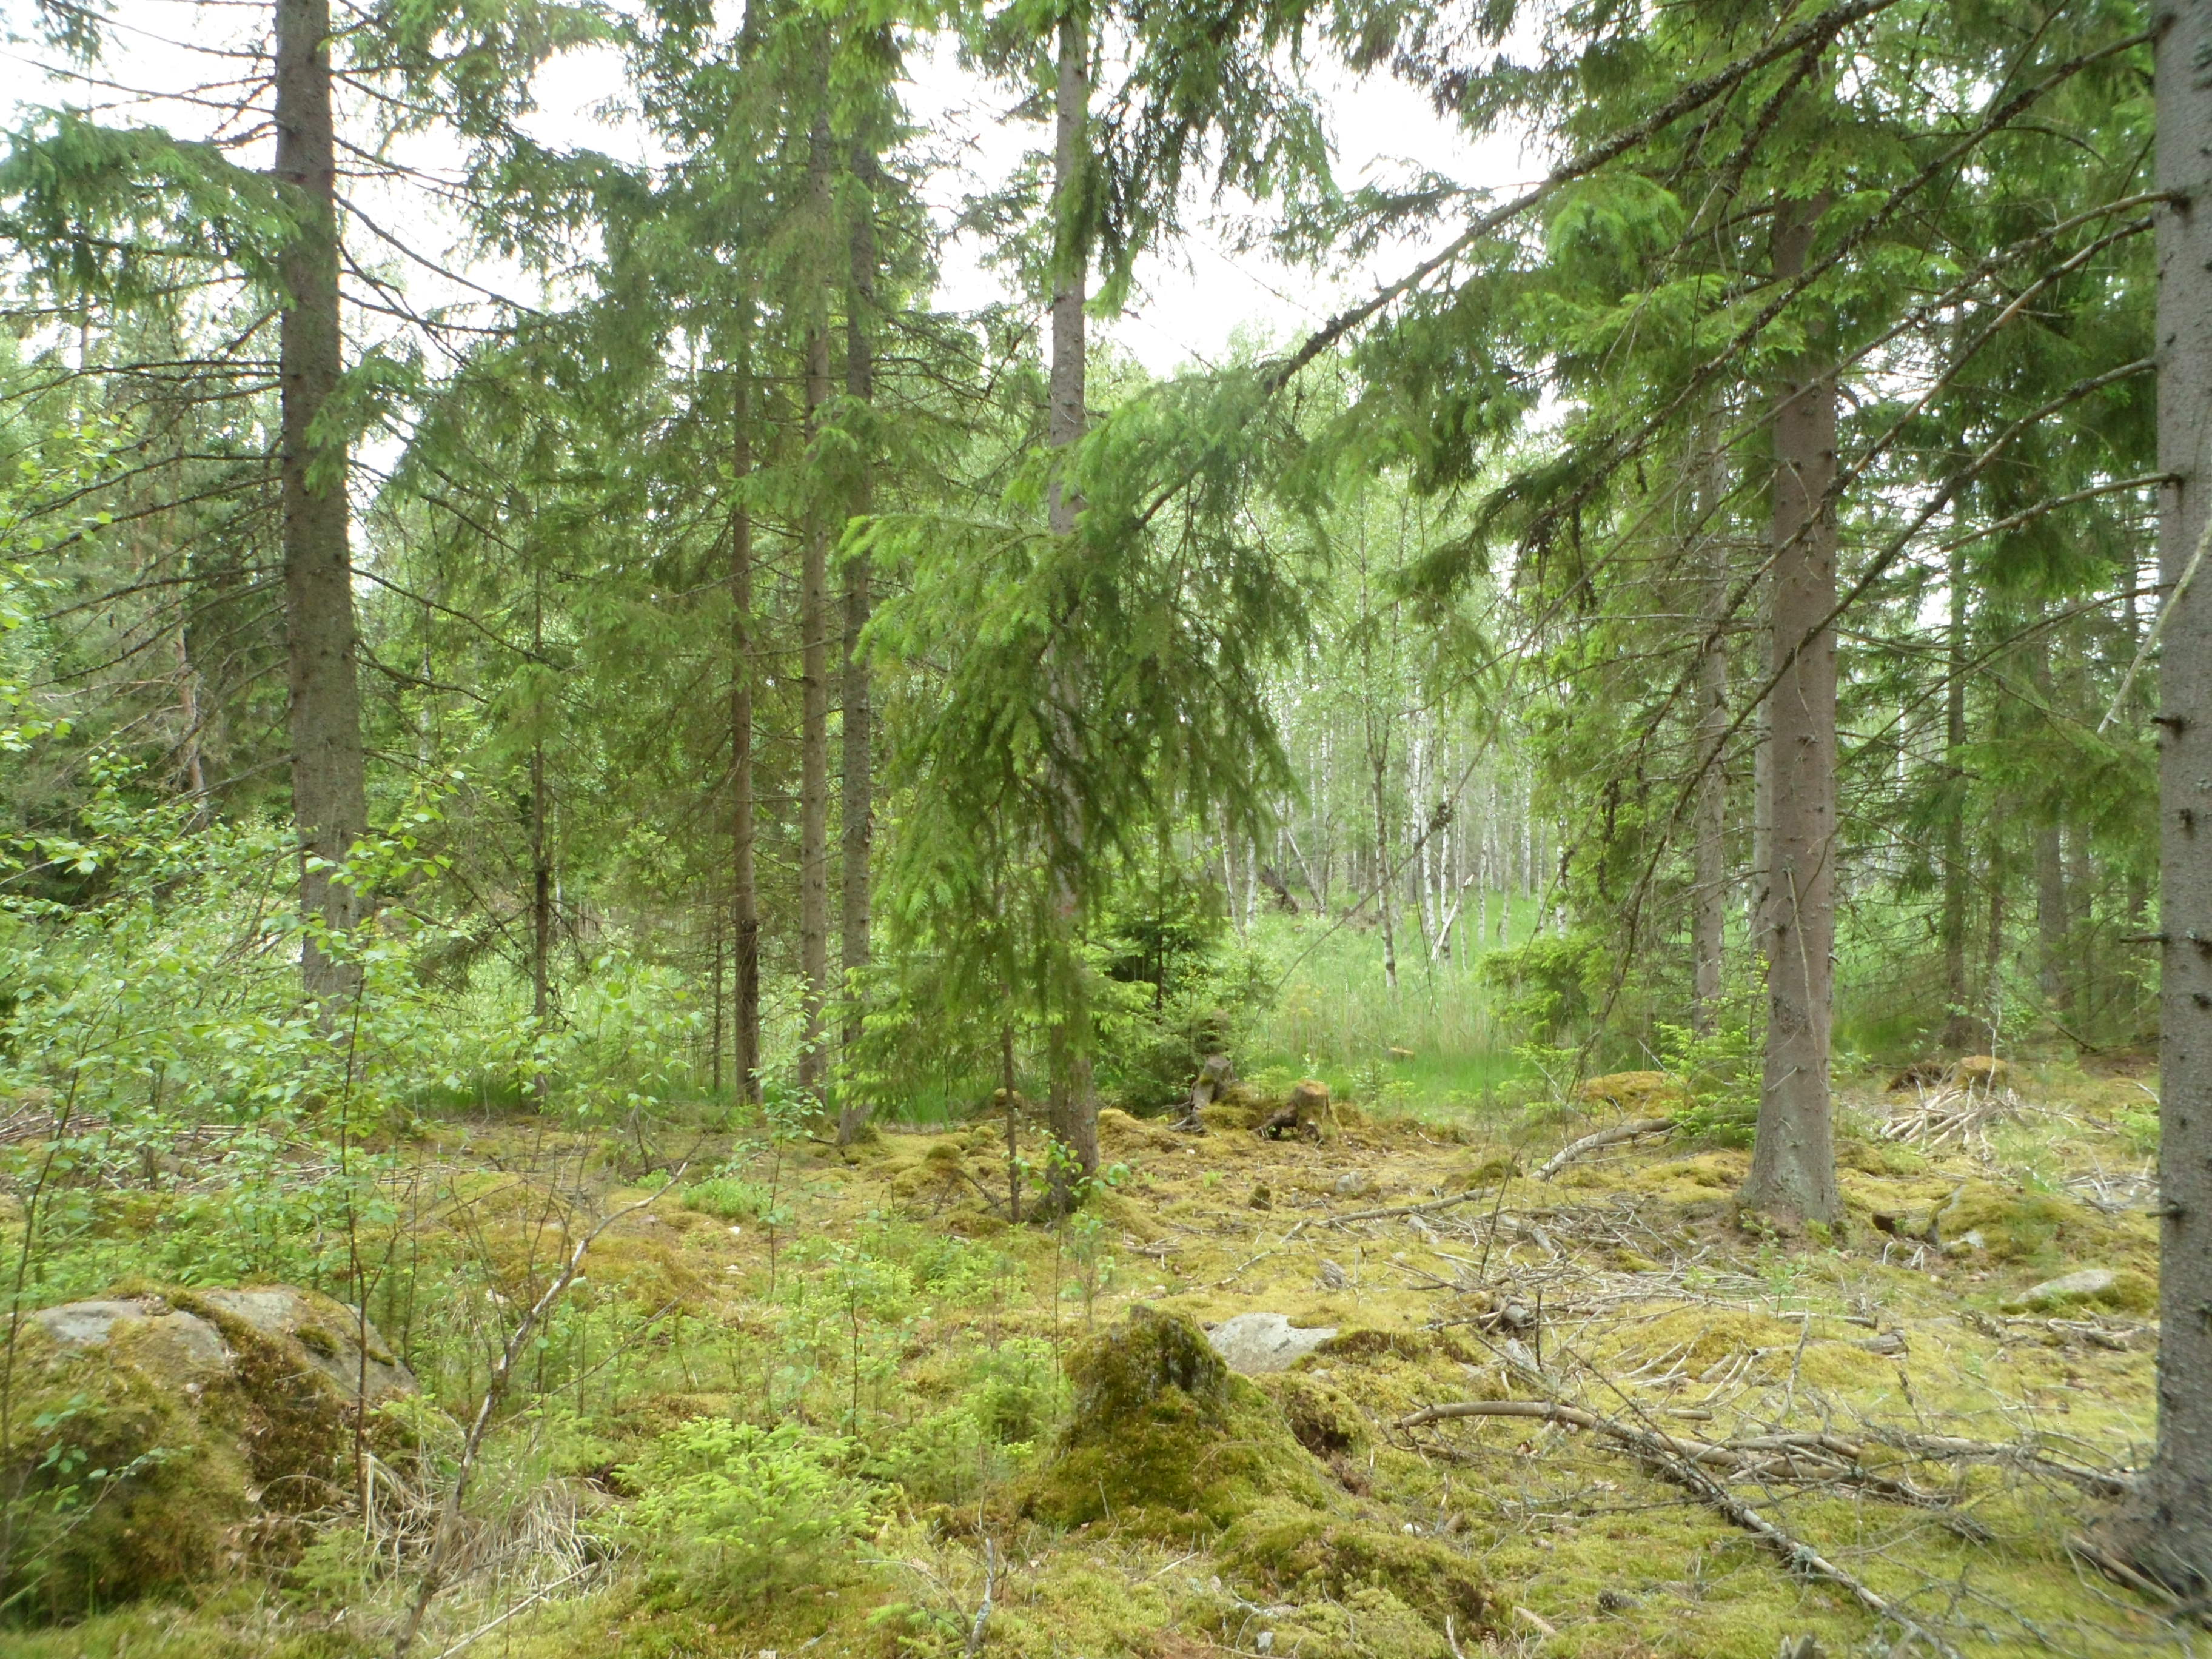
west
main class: Woodland
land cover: Spruce dominated coniferous woodland
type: boreal forest
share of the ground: 50 - 75 %
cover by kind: coniferous forest trees 65 %, lichens and mosses 20 %, broadleaved forest trees 10 %, shrubs 5 %
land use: Forestry
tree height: > 5 m
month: June
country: SE
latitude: 56.7933
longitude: 14.4993
